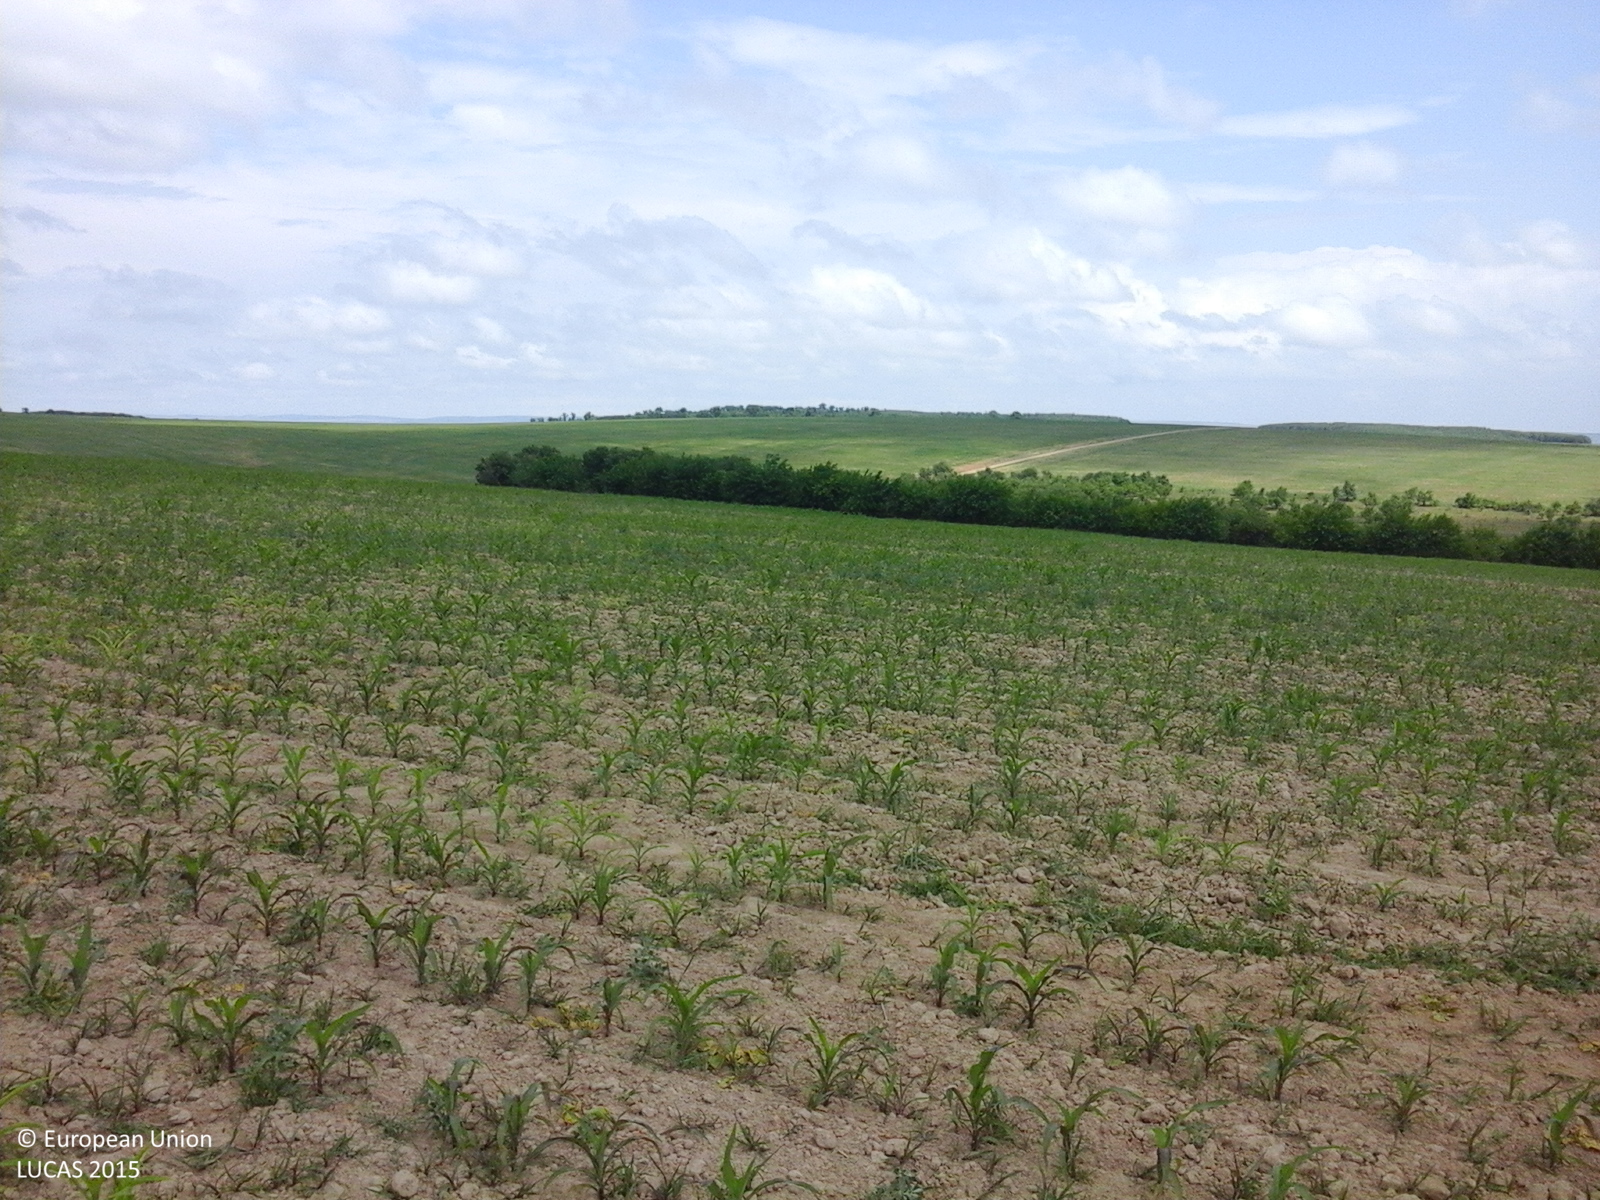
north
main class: Cropland
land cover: Maize
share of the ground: 10 - 25 %
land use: Agriculture (excluding fallow land and kitchen gardens)
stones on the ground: < 10 %
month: June
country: RO
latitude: 47.0480
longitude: 26.5812
